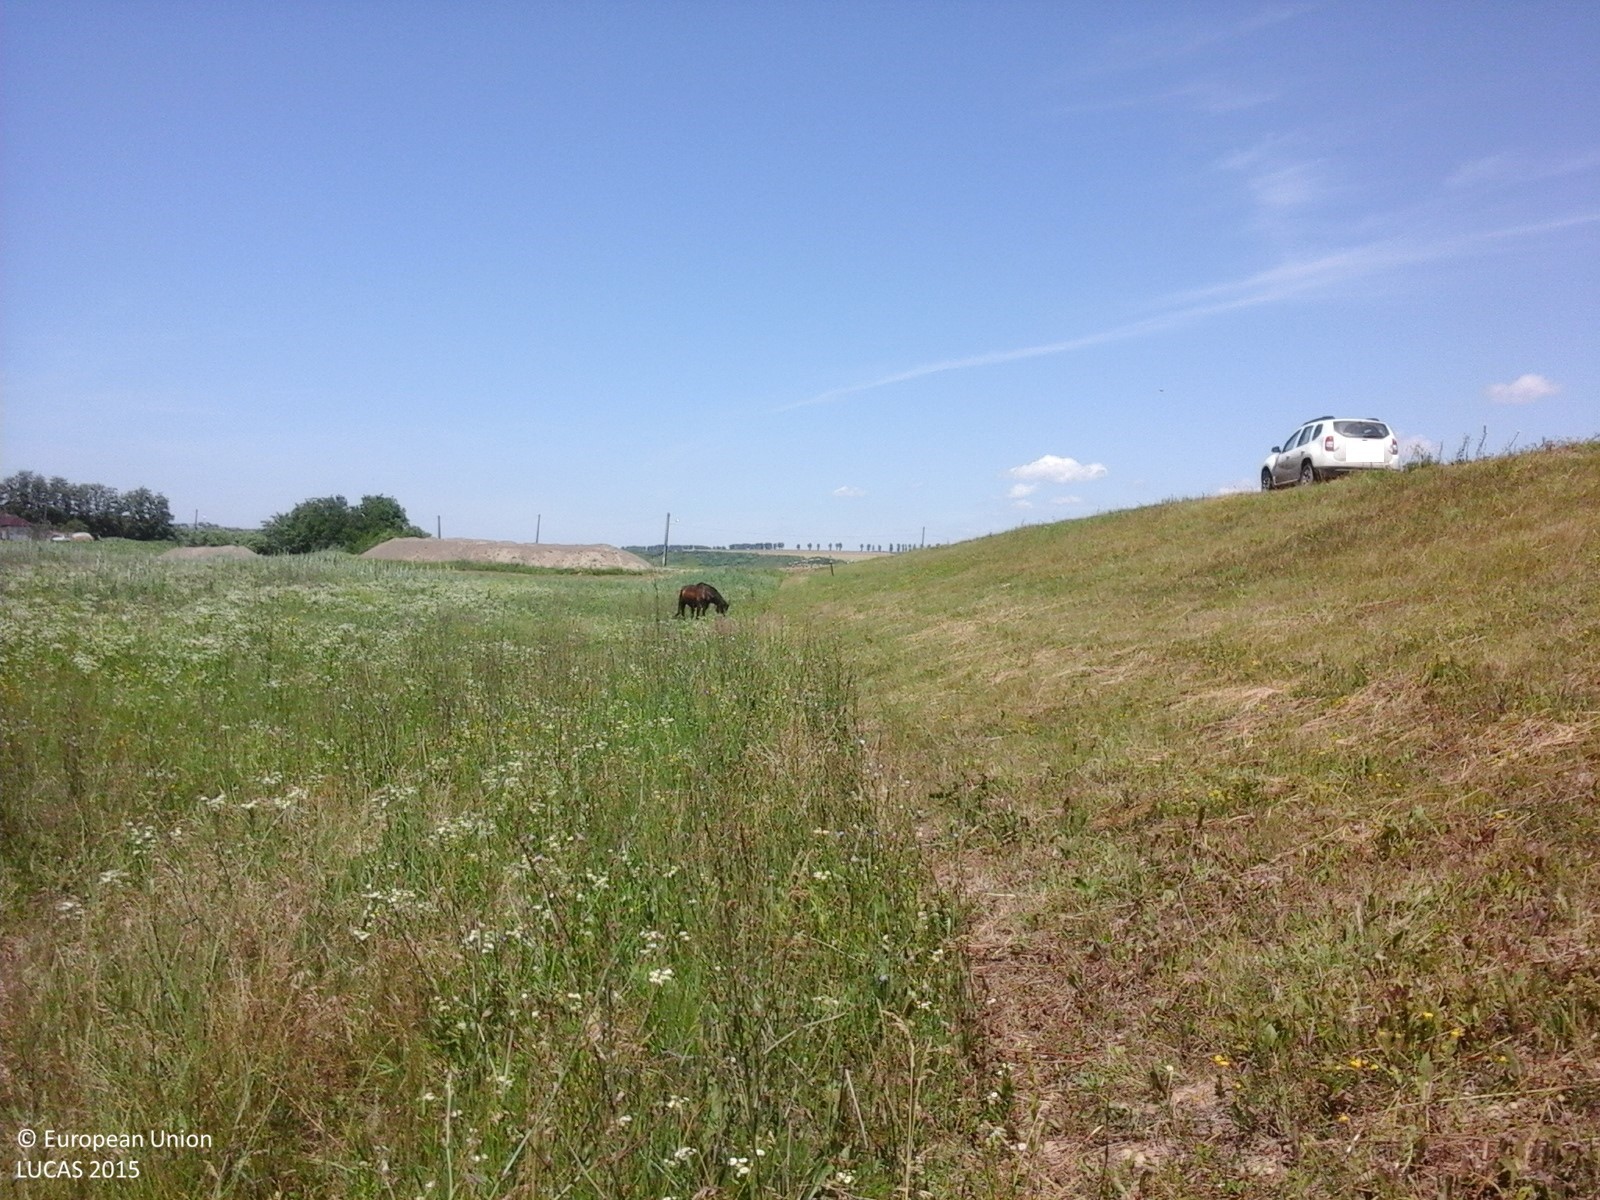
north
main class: Grassland
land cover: Grassland without tree/shrub cover
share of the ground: > 75 %
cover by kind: herbaceous plants 100 %
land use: Agriculture (excluding fallow land and kitchen gardens)
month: June
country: RO
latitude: 47.0262
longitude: 26.9533
